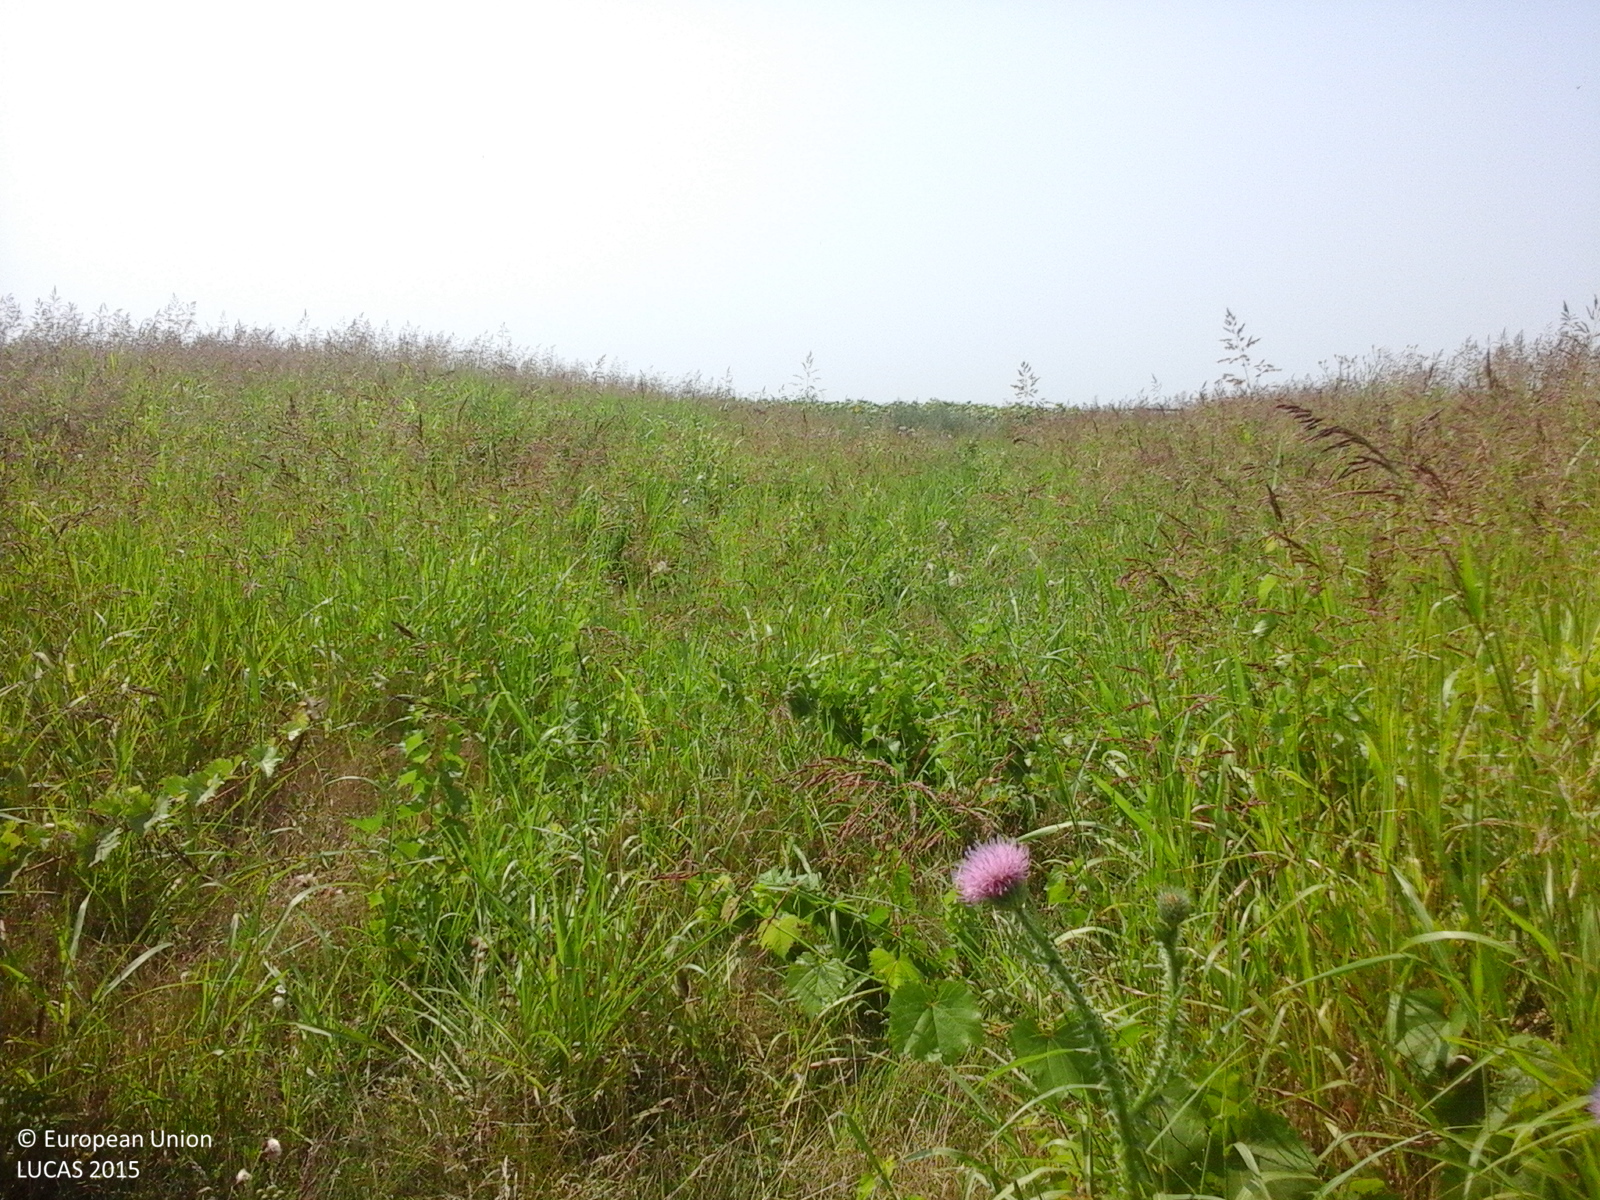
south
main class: Grassland
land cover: Spontaneously vegetated surfaces
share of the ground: > 75 %
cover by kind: herbaceous plants 100 %
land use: Semi-natural and natural areas not in use
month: July
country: RO
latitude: 44.7749
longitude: 26.6639
